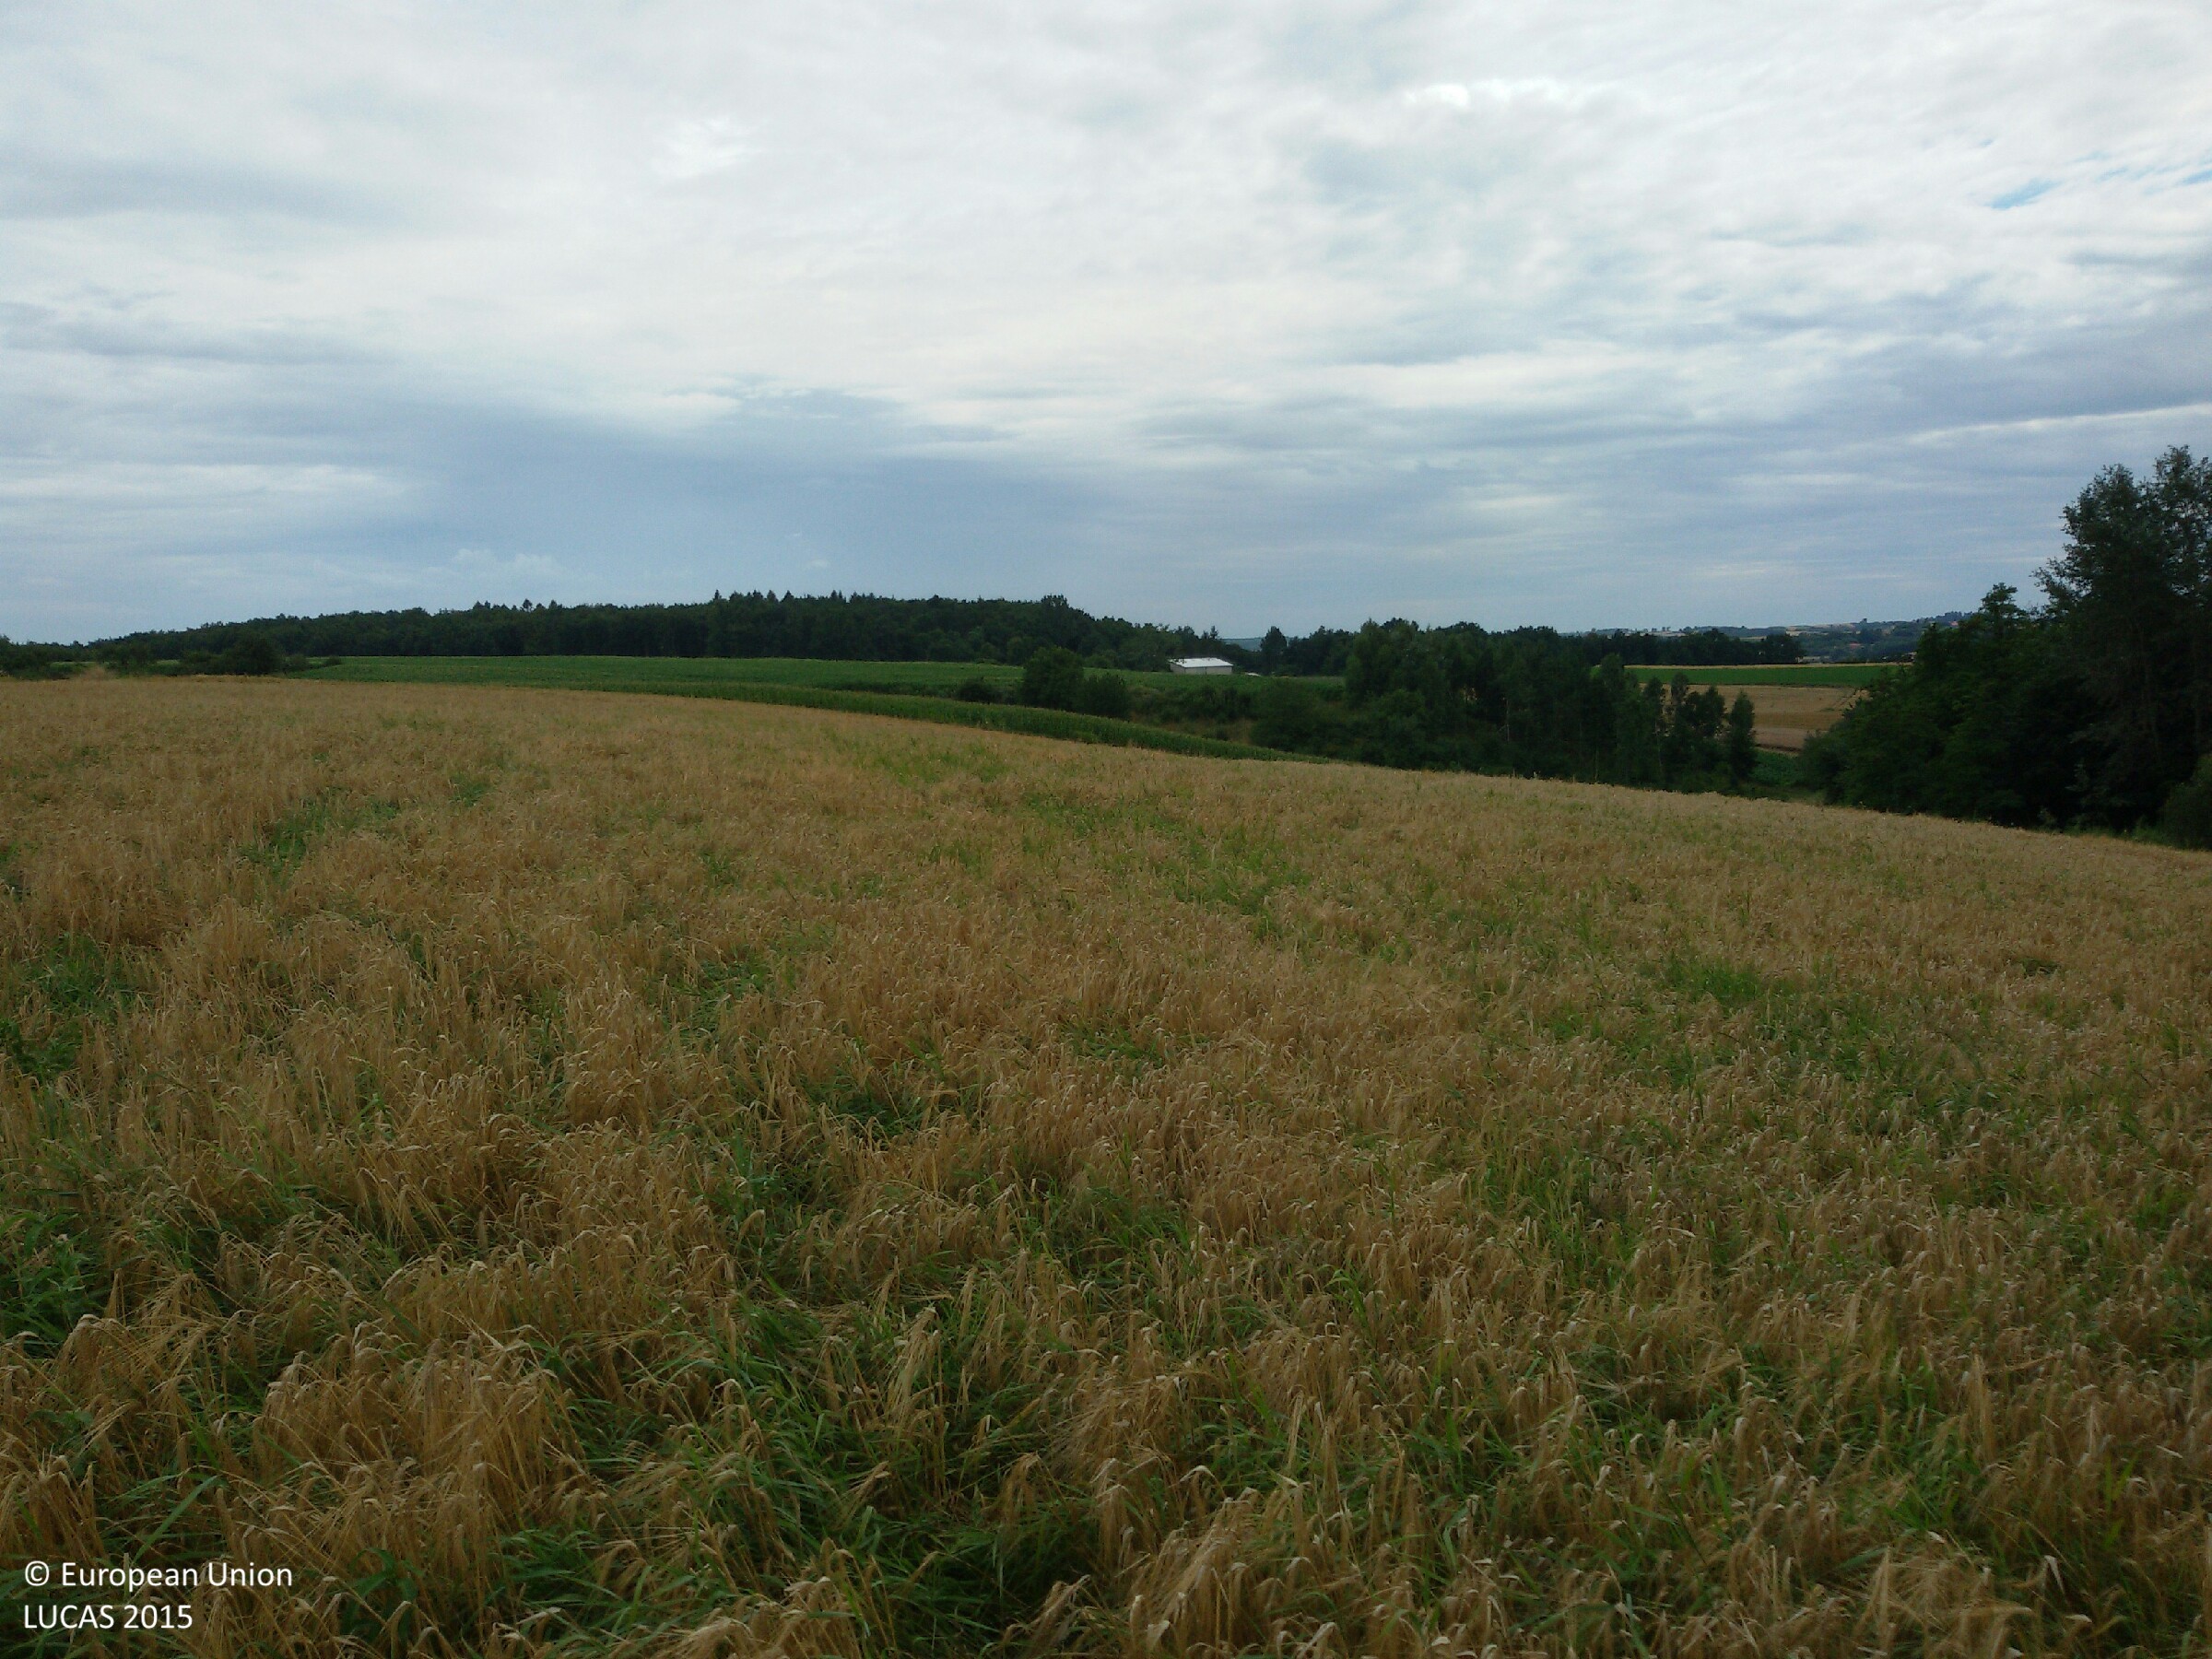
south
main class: Cropland
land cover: Barley
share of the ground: > 75 %
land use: Agriculture (excluding fallow land and kitchen gardens)
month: July
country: PL
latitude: 50.7011
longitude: 21.3905
